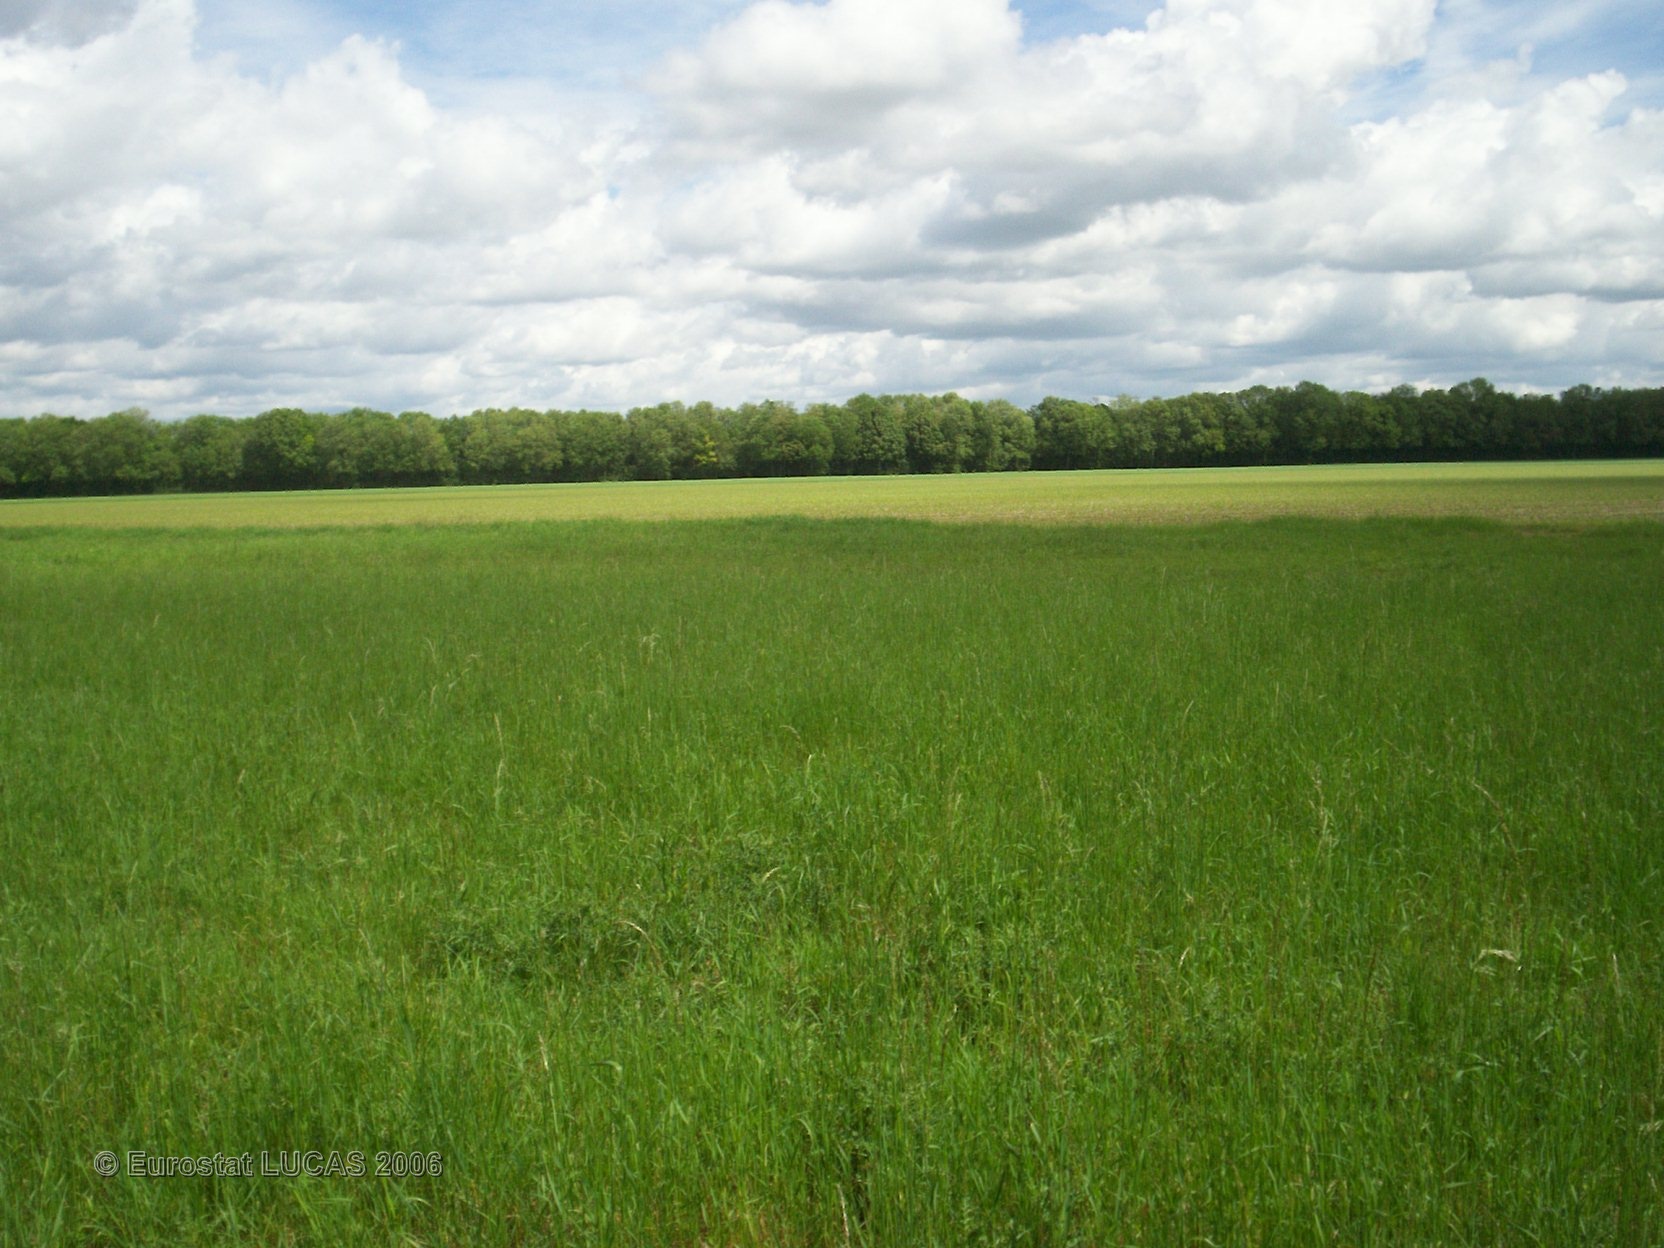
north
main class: Grassland
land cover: Grassland without tree/shrub cover
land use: Agriculture (excluding fallow land and kitchen gardens)
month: May
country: FR
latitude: 49.4881
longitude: 4.4051
